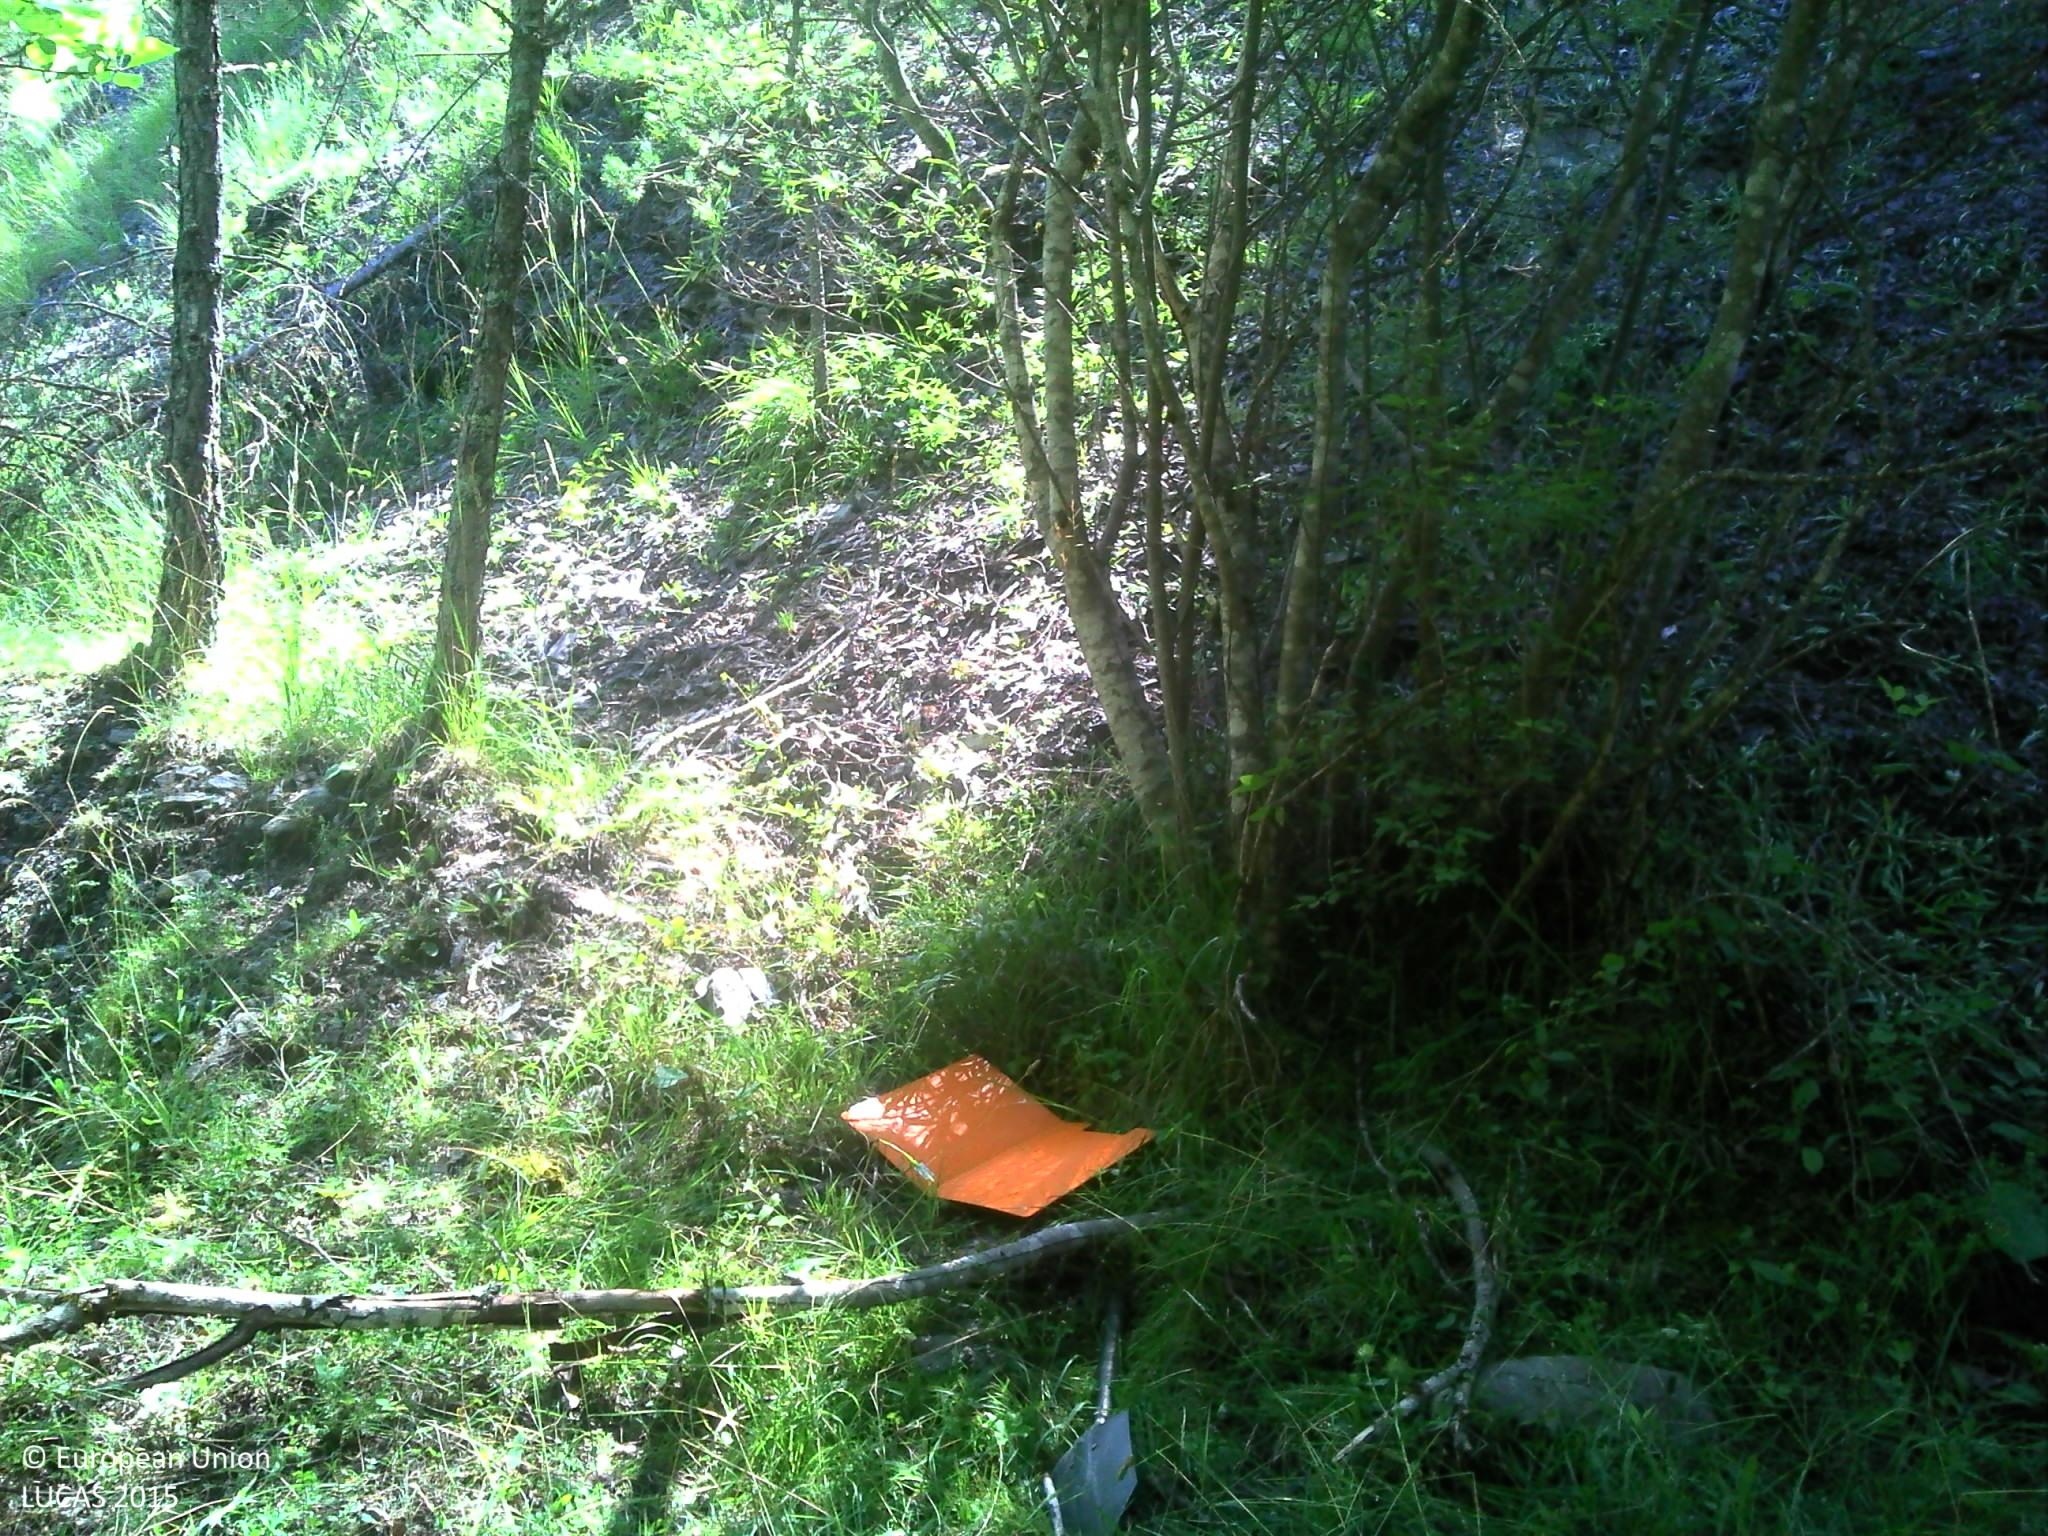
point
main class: Woodland
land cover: Pine dominated mixed woodland
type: alpine coniferous forest
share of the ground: 50 - 75 %
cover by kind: coniferous forest trees 30 %, broadleaved forest trees 20 %, shrubs 20 %, herbaceous plants 20 %, consolidated bare surface 10 %
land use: Forestry
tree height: > 5 m
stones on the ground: 10 - 25 %
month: August
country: FR
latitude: 44.3363
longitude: 6.2319
